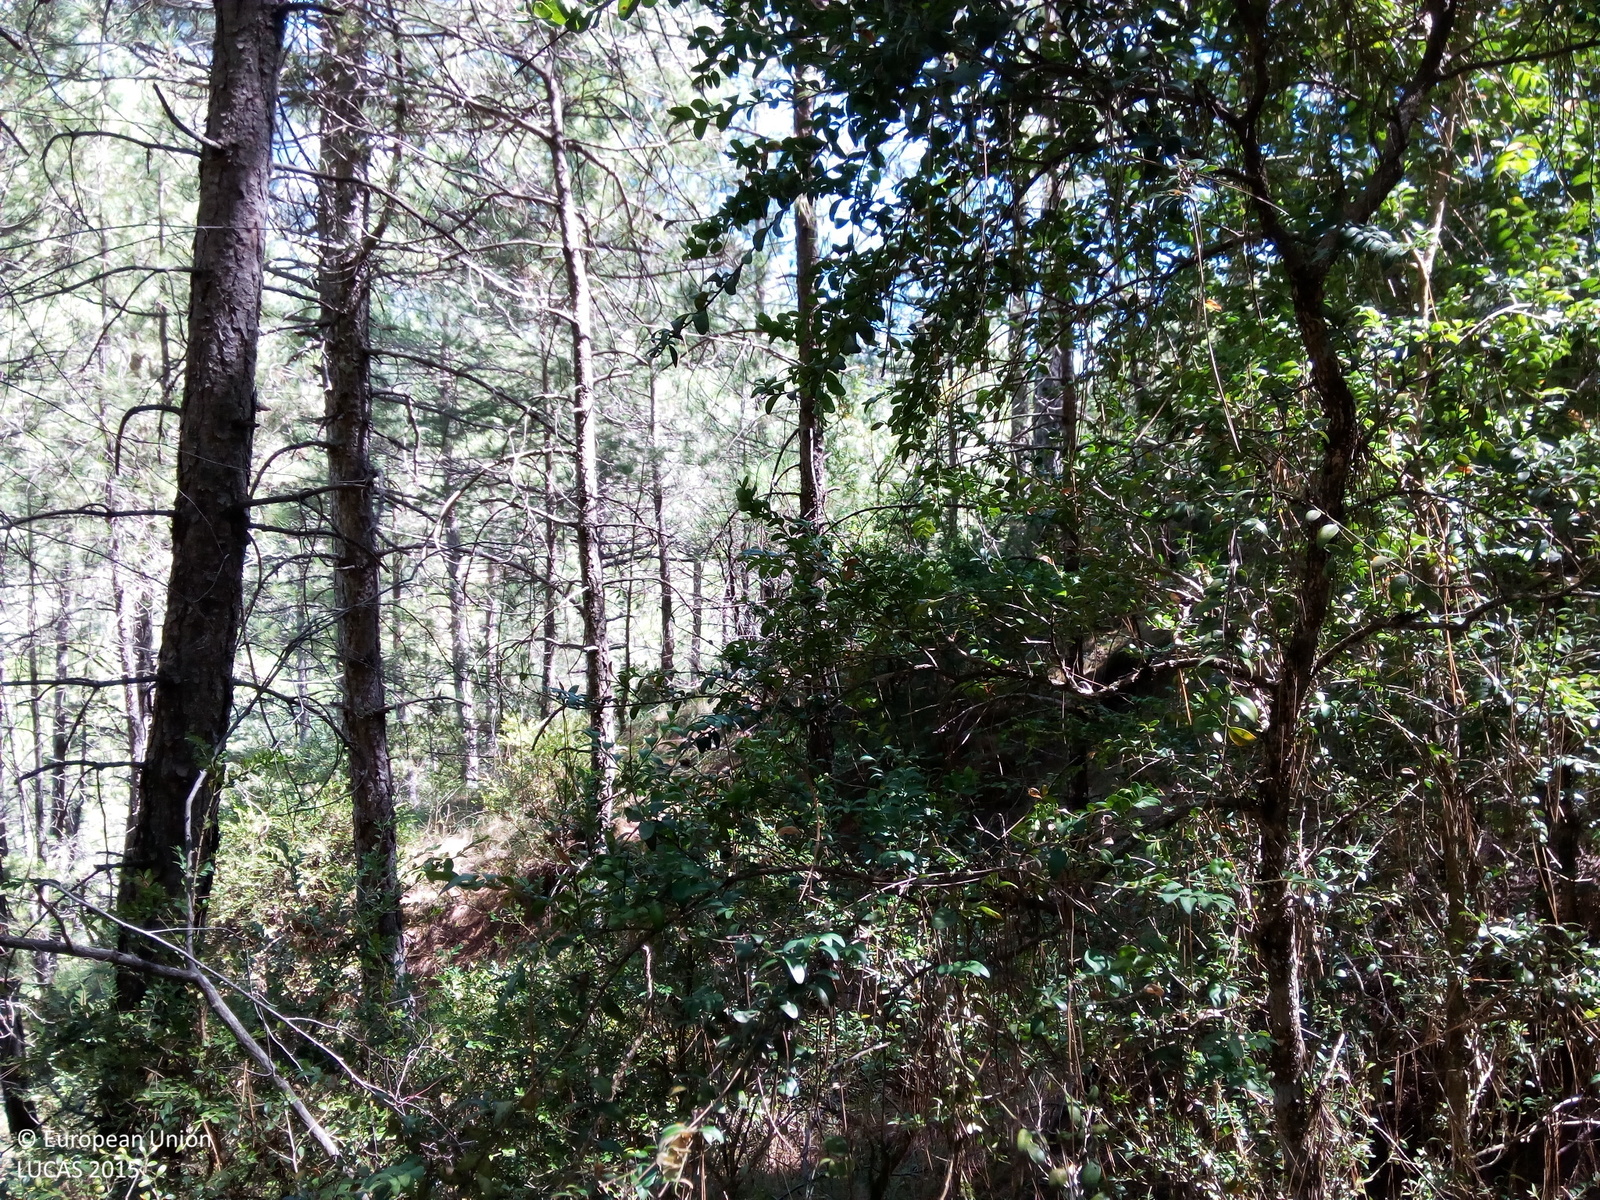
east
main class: Woodland
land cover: Pine dominated coniferous woodland
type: coniferous forest of the mediterranean region
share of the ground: > 75 %
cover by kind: coniferous forest trees 100 %
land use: Forestry
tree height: > 5 m
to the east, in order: Pine dominated coniferous woodland; Tracks; Pine dominated coniferous woodland; Rivers and streams; Broadleaved woodland; Grassland without tree/shrub cover; Shrubland without tree cover; Grassland without tree/shrub cover; Shruby margins; Grassland without tree/shrub cover; Electric lines; Grassland without tree/shrub cover
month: August
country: ES
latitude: 42.4651
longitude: 0.1641
